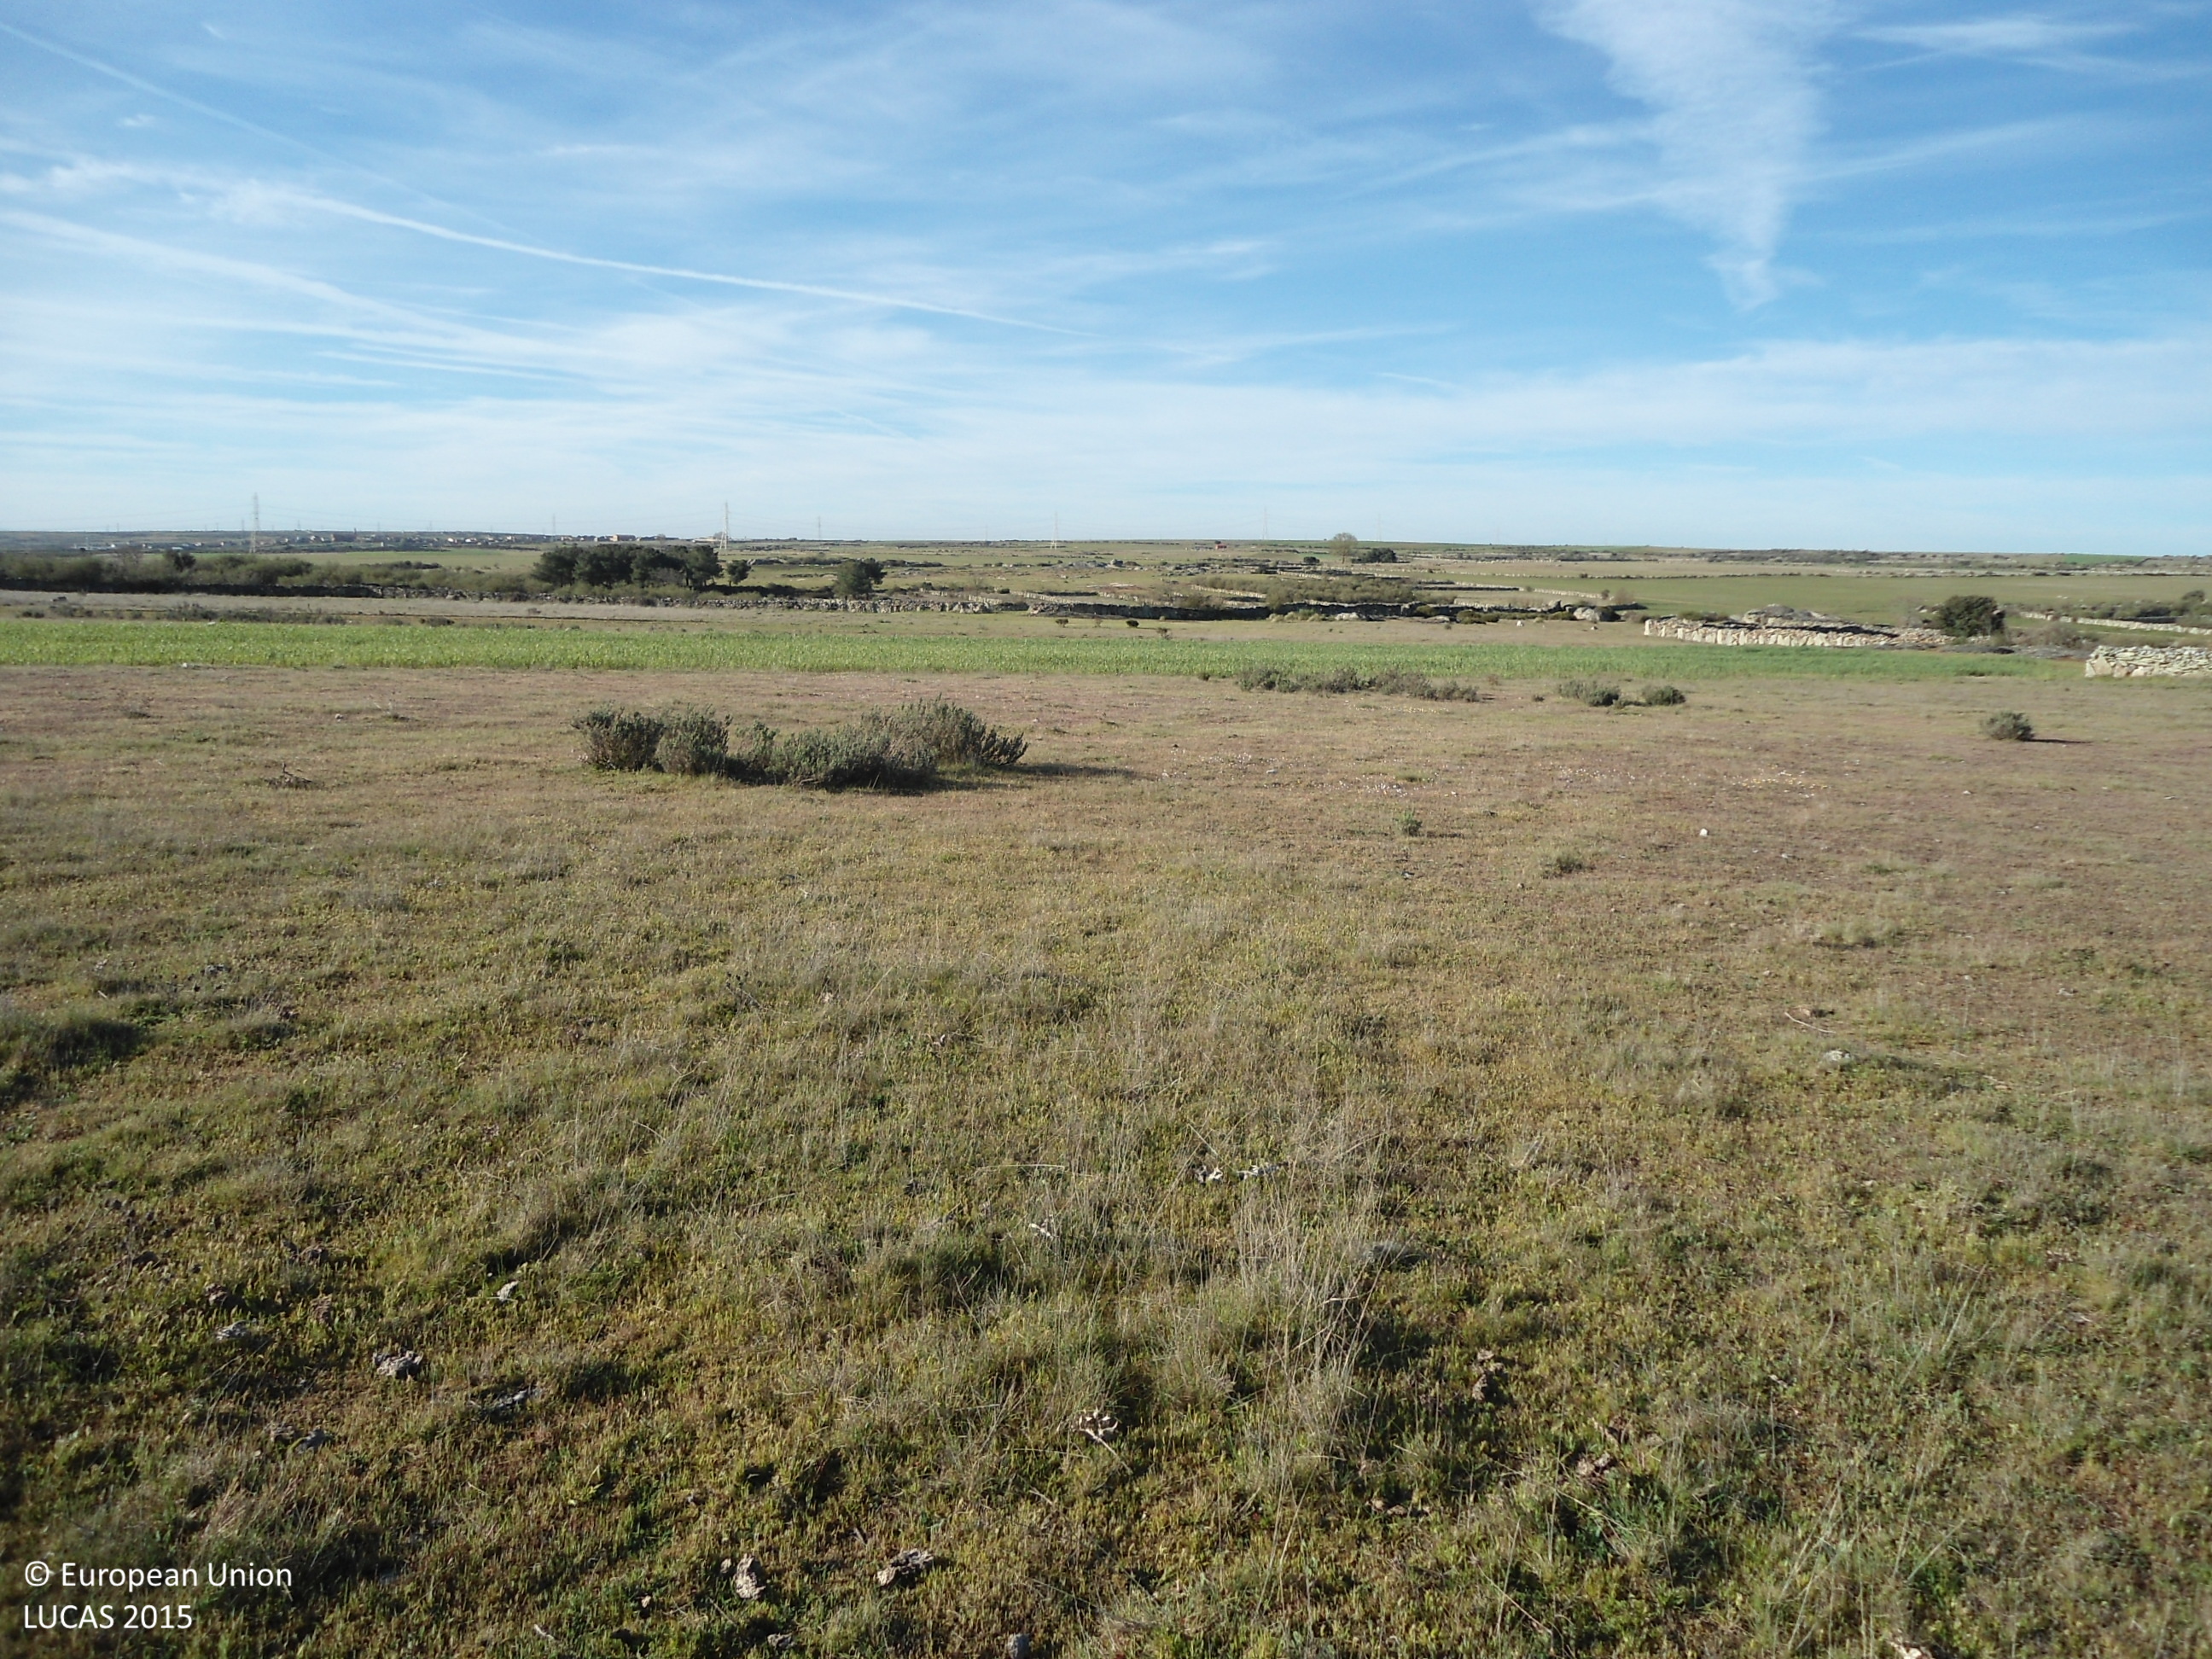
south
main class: Grassland
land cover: Grassland without tree/shrub cover
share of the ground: > 75 %
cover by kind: herbaceous plants 100 %
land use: Agriculture (excluding fallow land and kitchen gardens)
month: April
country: ES
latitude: 41.5481
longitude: -6.0499
